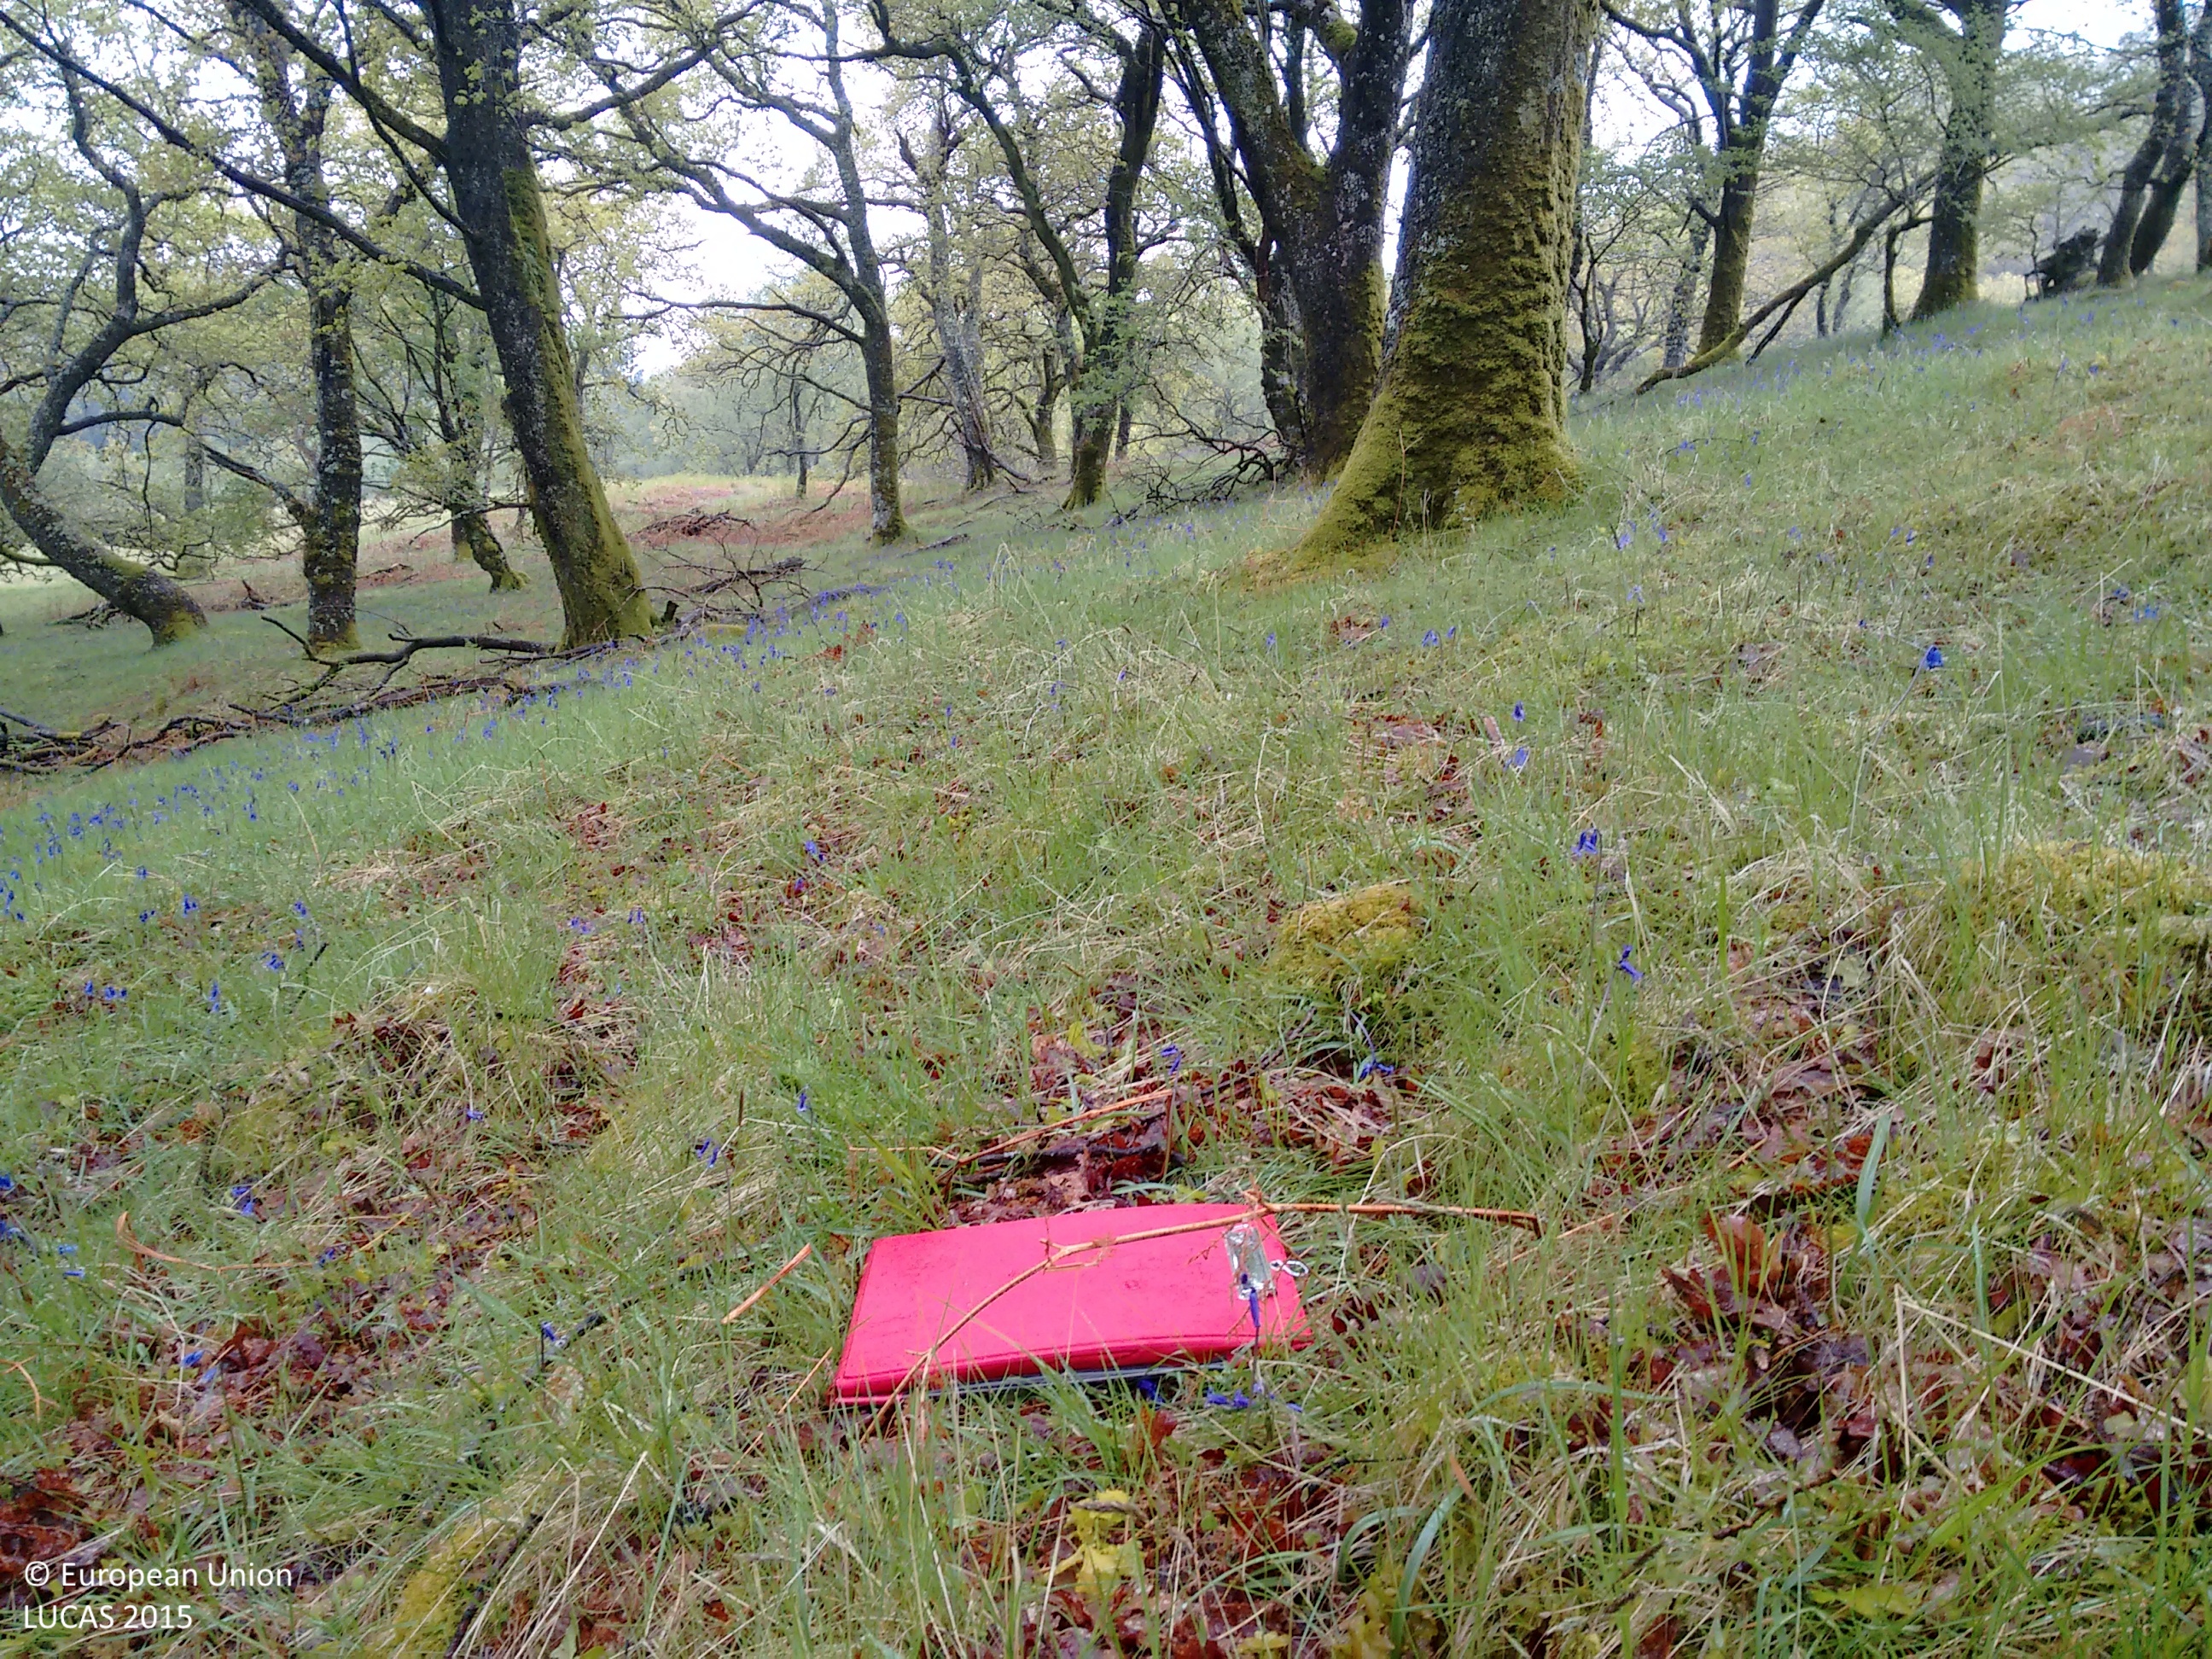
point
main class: Woodland
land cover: Broadleaved woodland
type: acidophilous oak and oak-birch forest
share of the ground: > 75 %
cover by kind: broadleaved forest trees 100 %
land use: Semi-natural and natural areas not in use
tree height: > 5 m
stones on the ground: 10 - 25 %
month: June
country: GB
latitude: 56.1548
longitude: -5.1990
